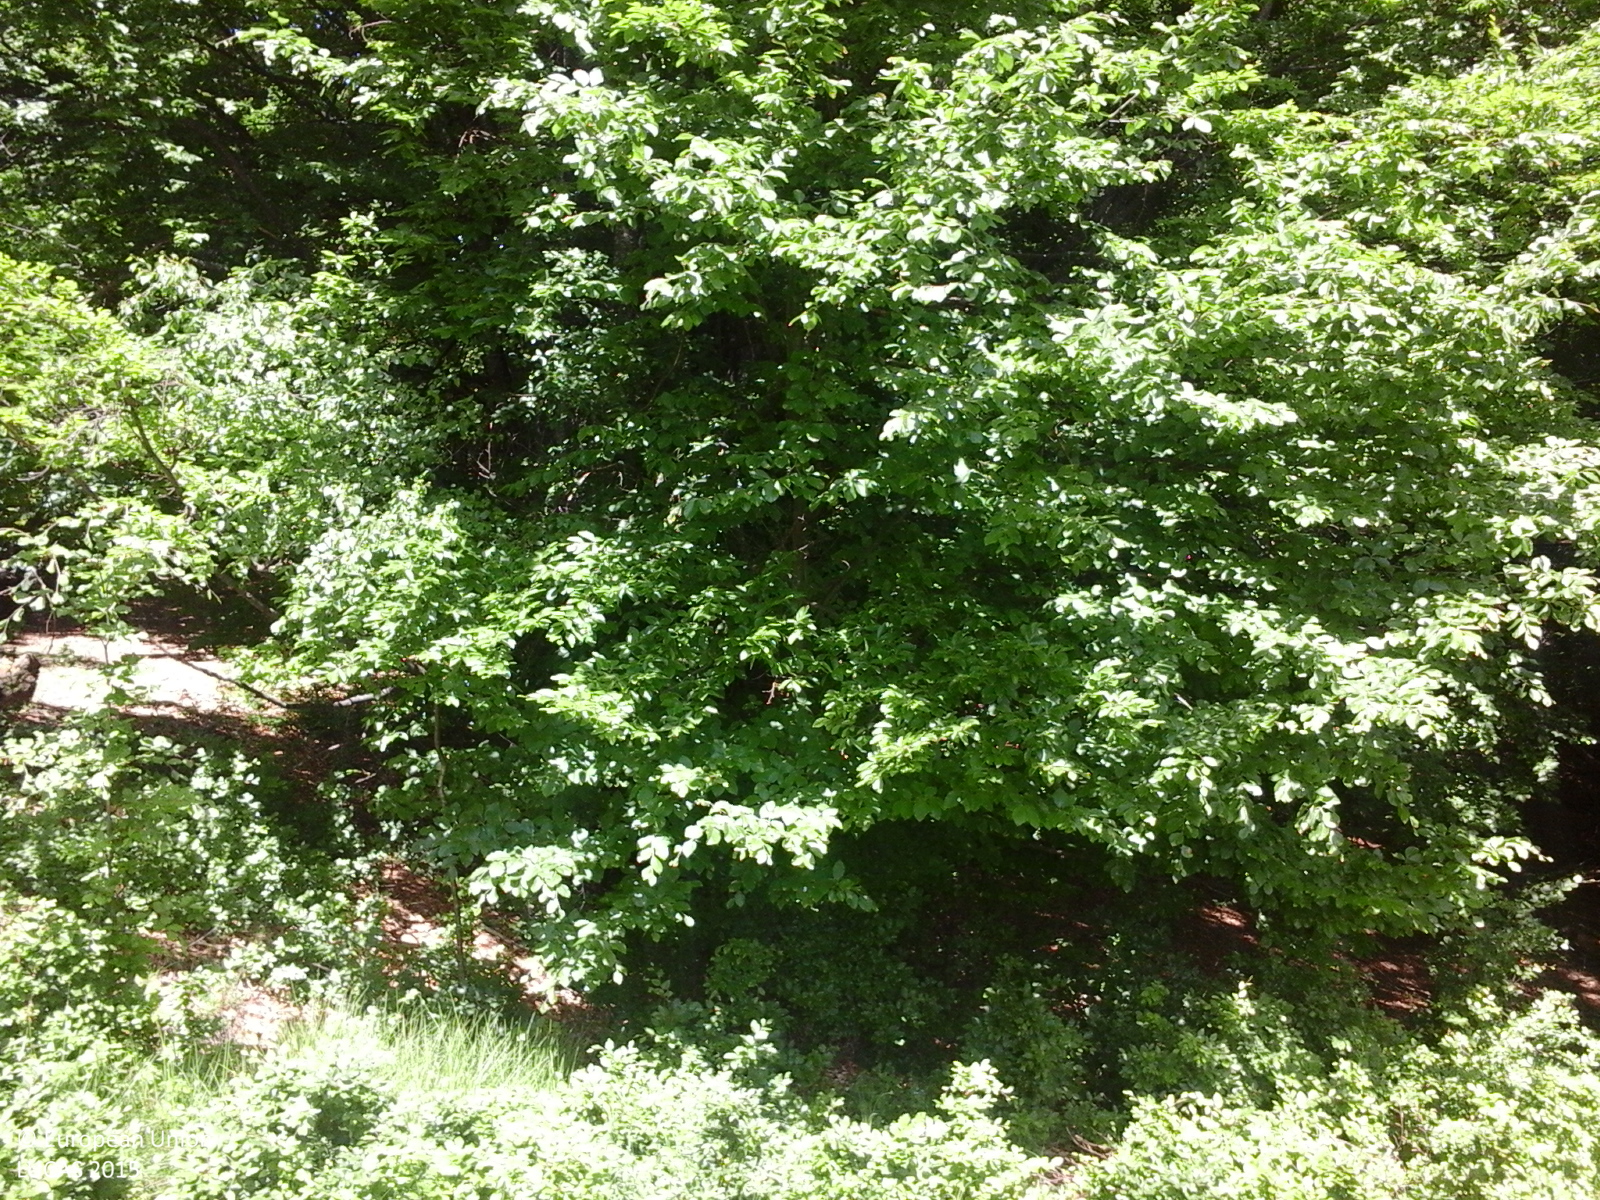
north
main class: Grassland
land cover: Grassland with sparse tree/shrub cover
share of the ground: > 75 %
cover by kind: herbaceous plants 90 %, broadleaved forest trees 5 %, shrubs 5 %
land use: Forestry
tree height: > 5 m
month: May
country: RO
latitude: 45.3974
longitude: 26.0951
